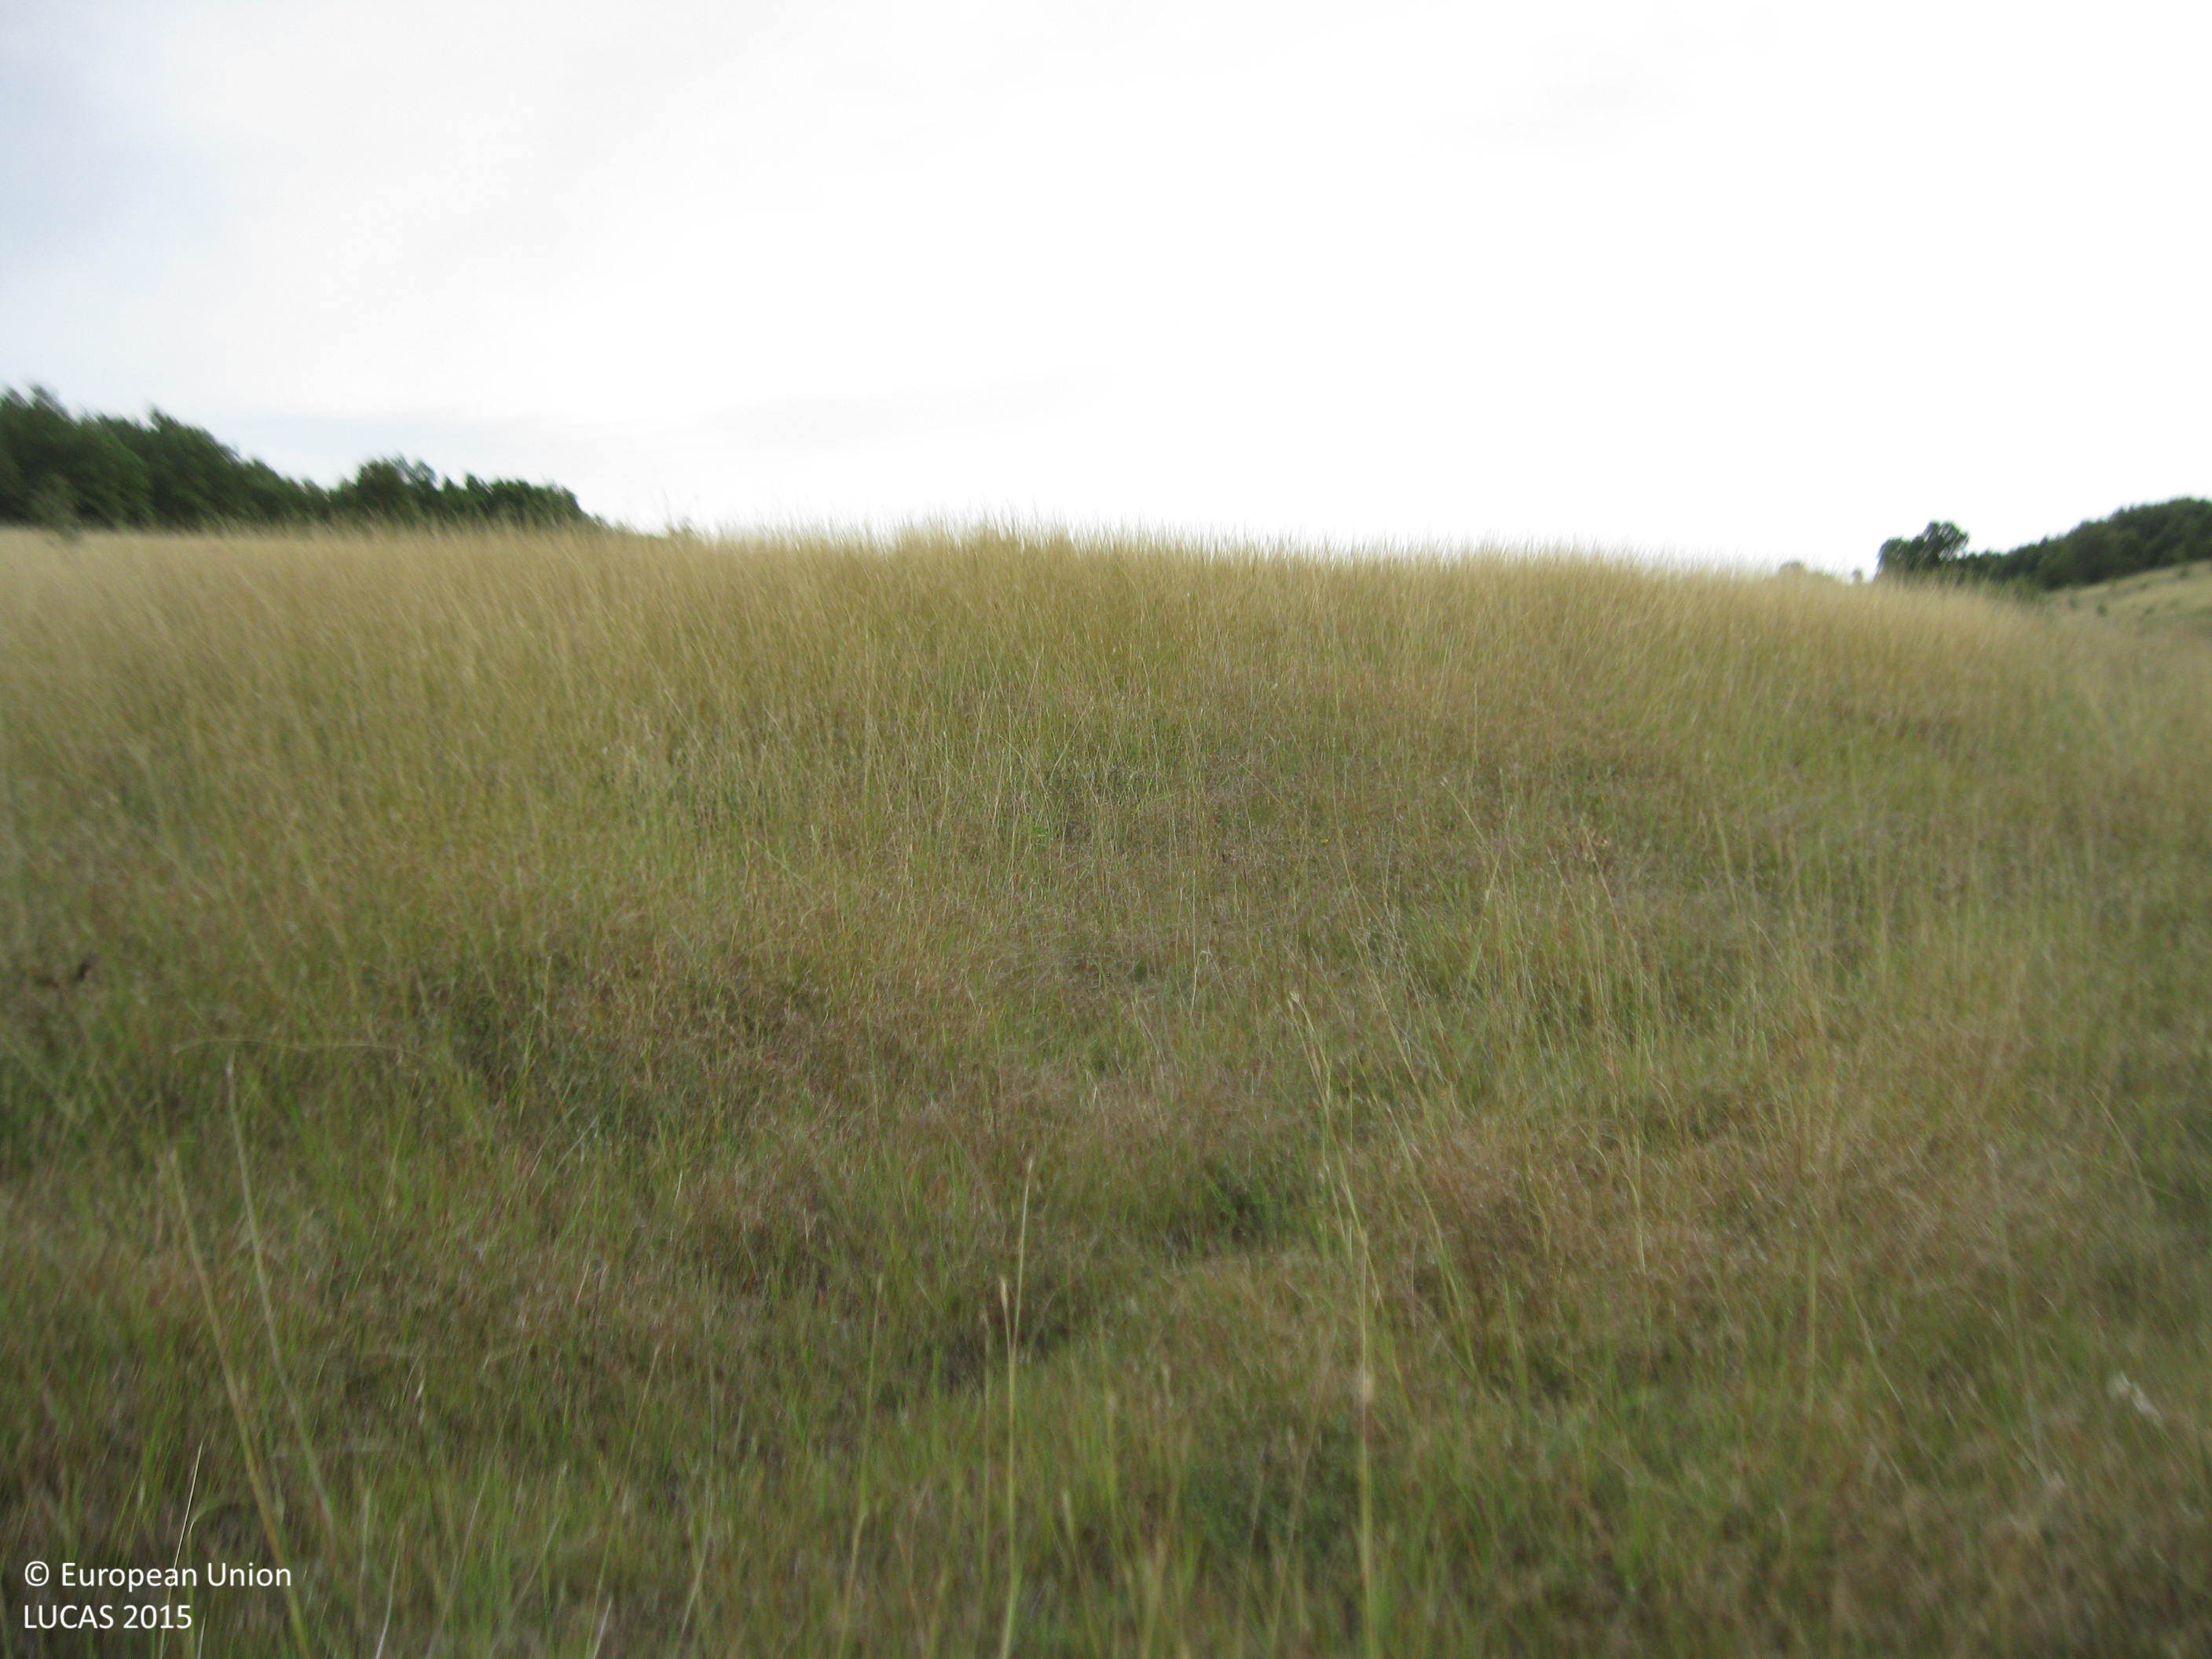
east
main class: Grassland
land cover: Grassland without tree/shrub cover
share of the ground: > 75 %
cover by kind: herbaceous plants 100 %
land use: Agriculture (excluding fallow land and kitchen gardens)
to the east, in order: Grassland without tree/shrub cover; Tracks; Grassland without tree/shrub cover
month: September
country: BG
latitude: 42.1068
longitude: 25.0643
